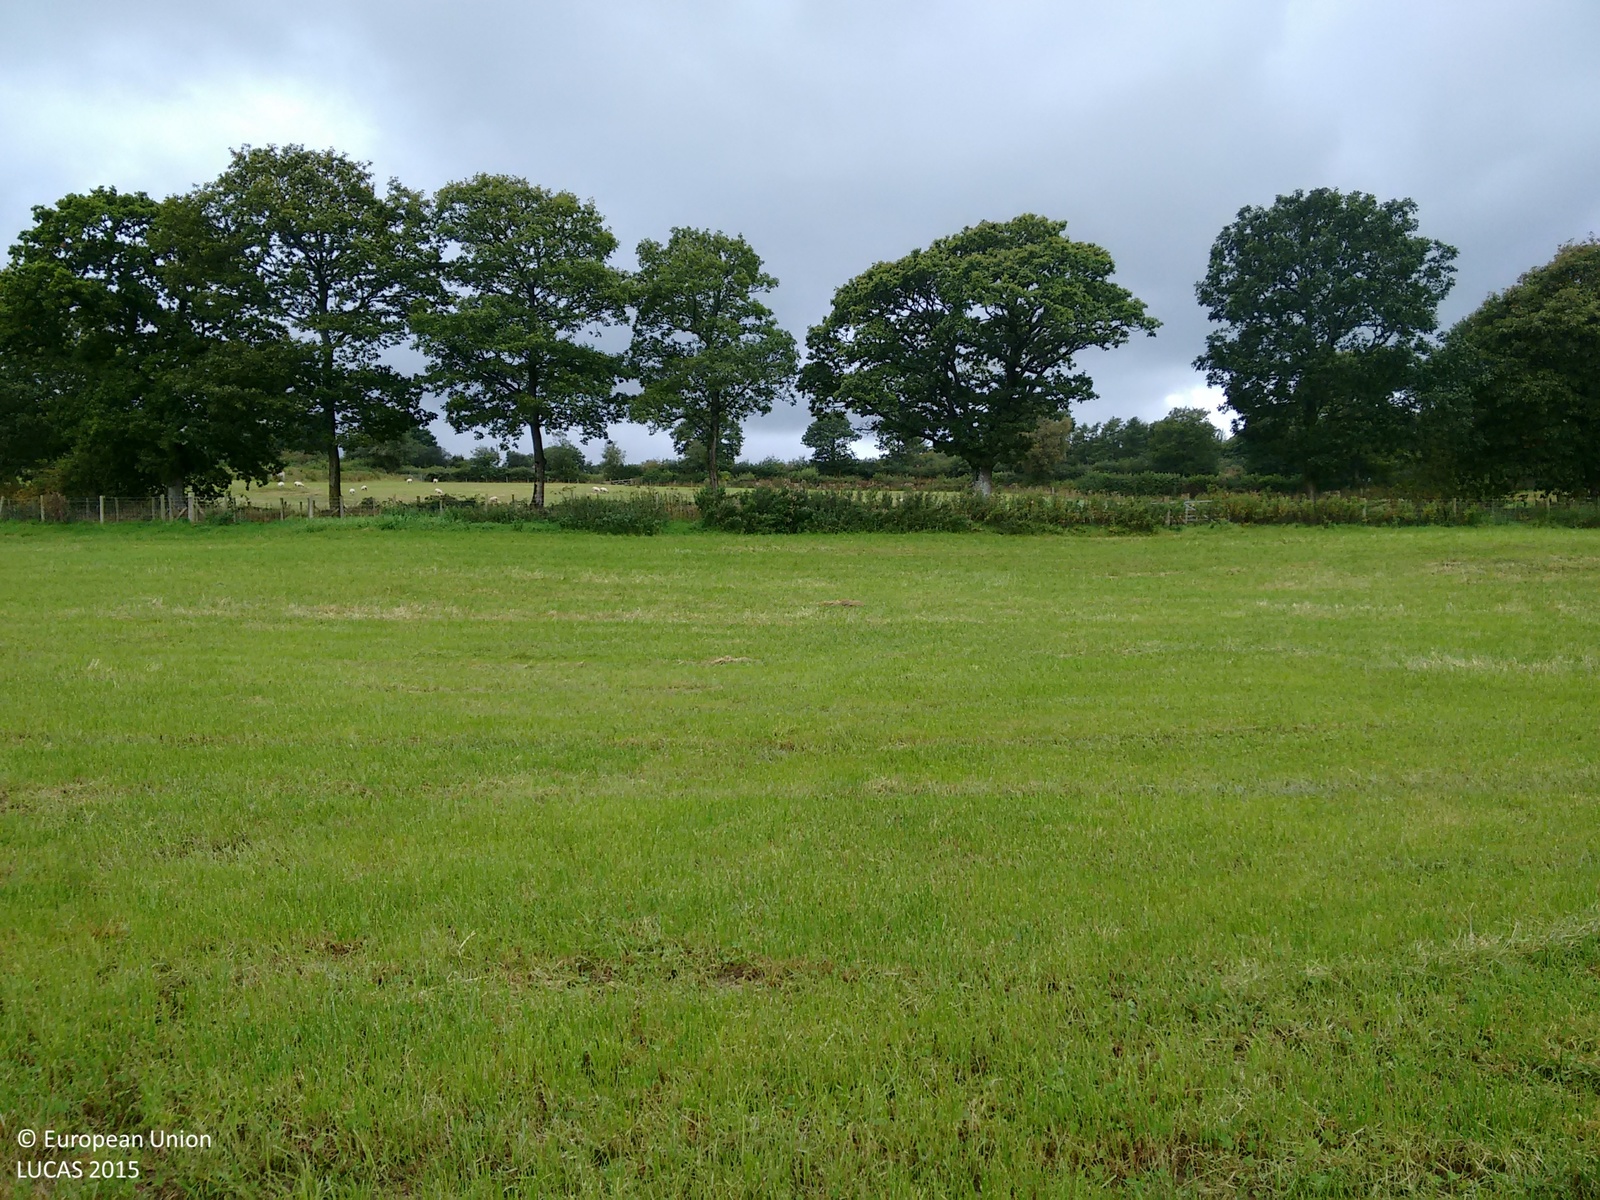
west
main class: Cropland
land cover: Temporary grasslands
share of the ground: > 75 %
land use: Agriculture (excluding fallow land and kitchen gardens)
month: September
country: GB
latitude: 52.1741
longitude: -4.0606
